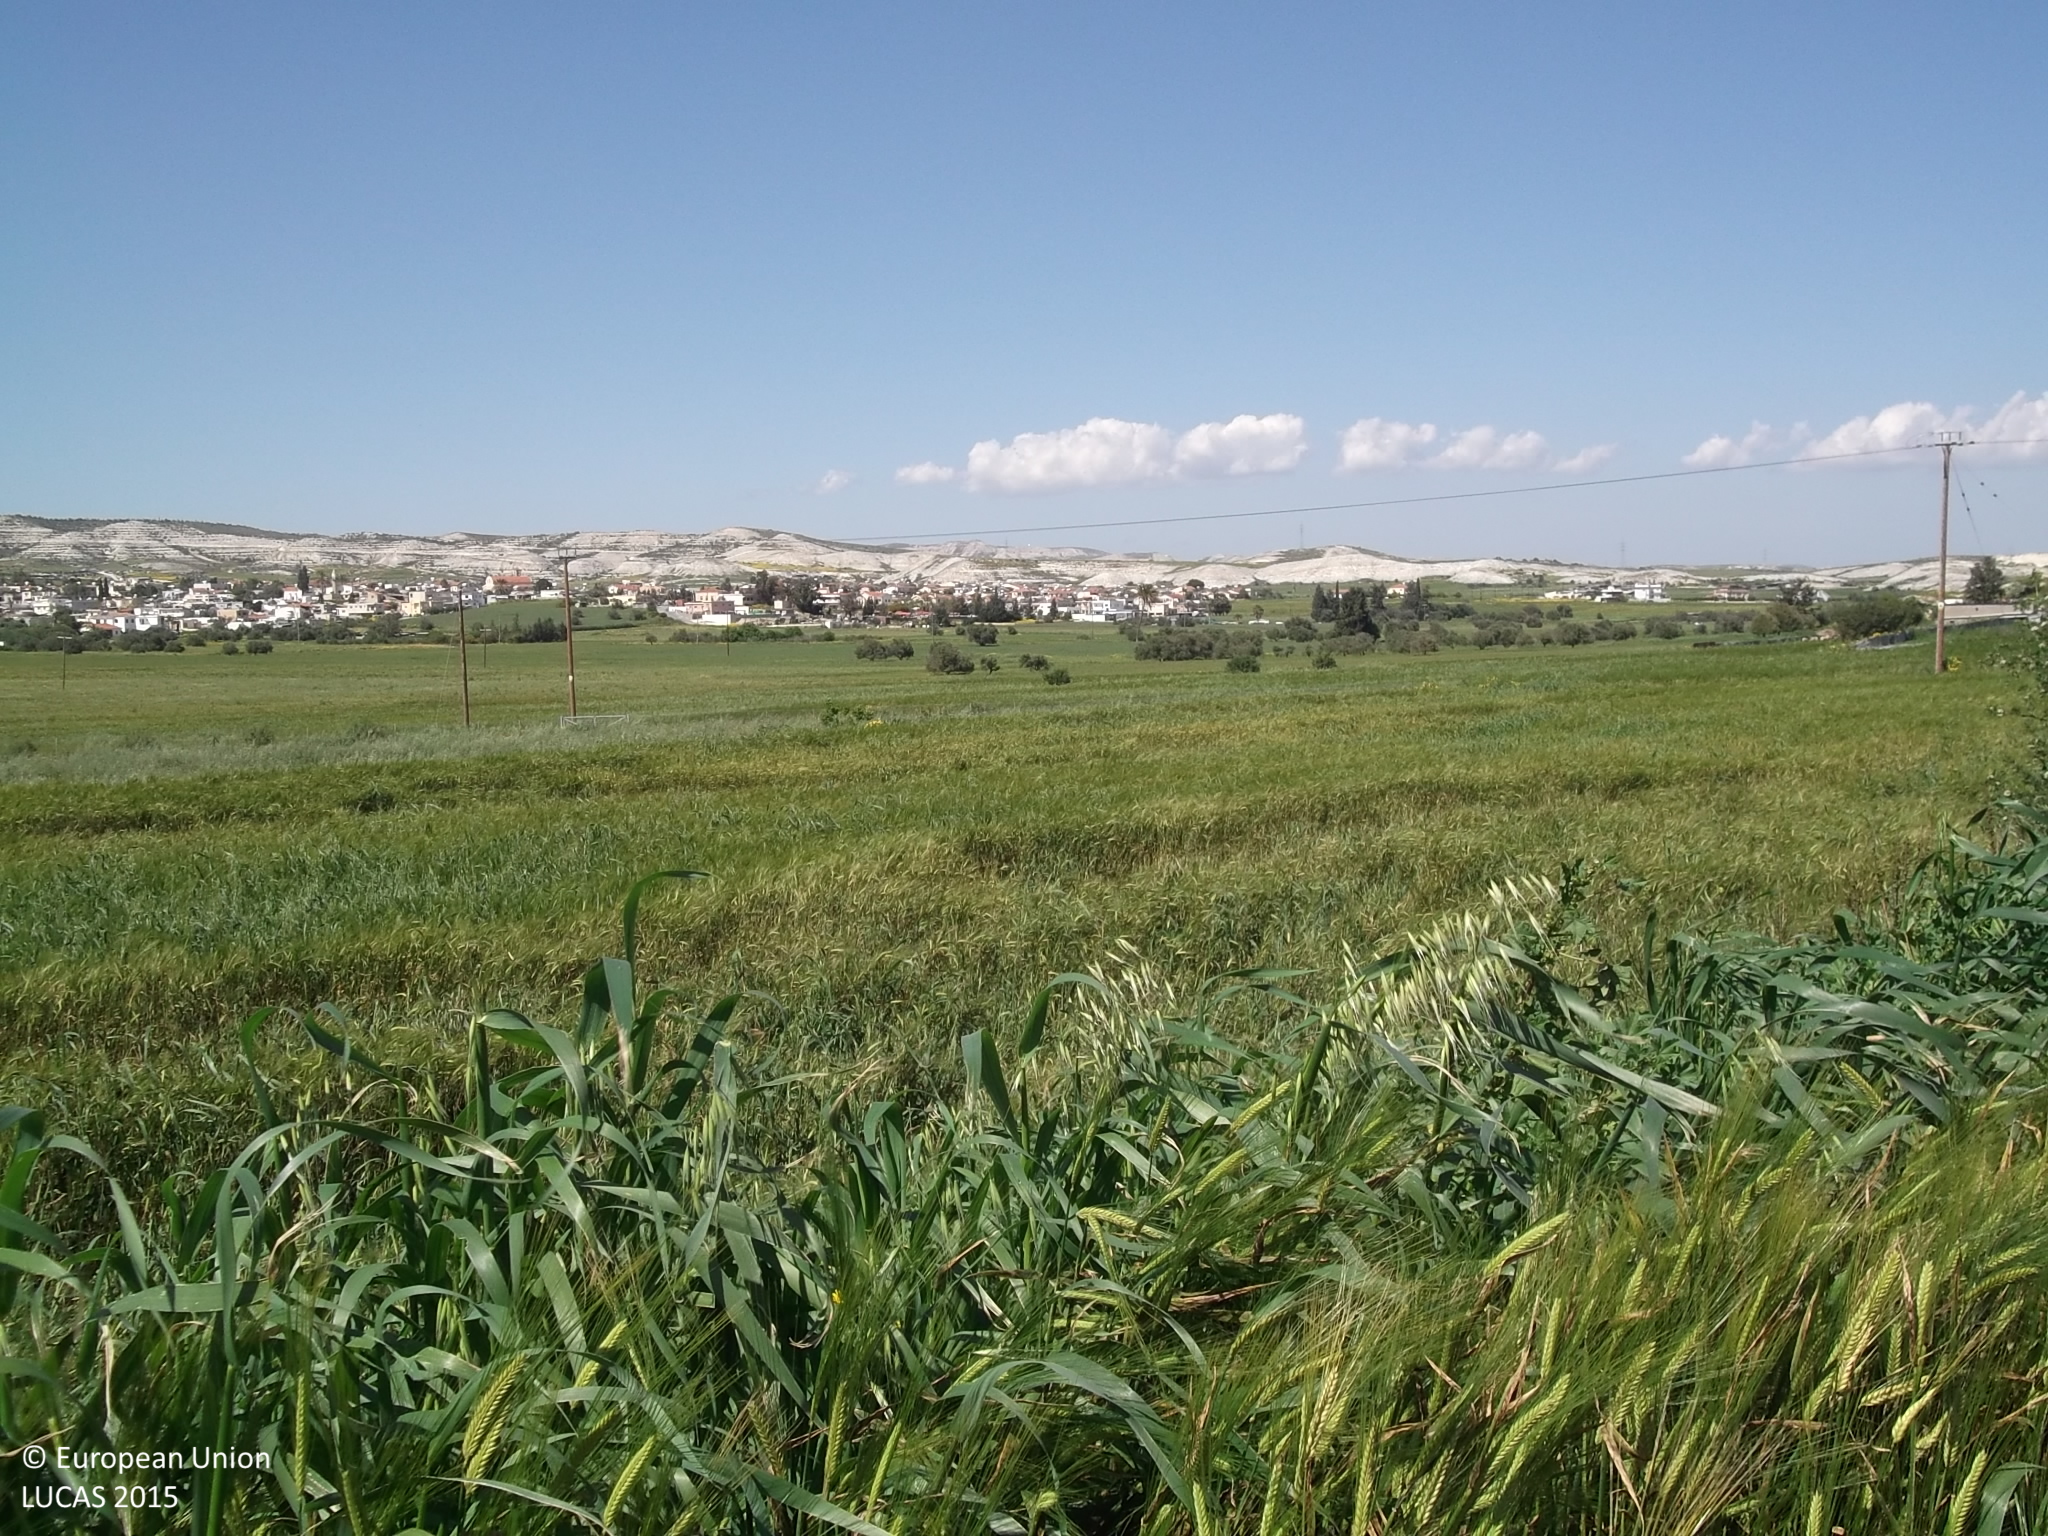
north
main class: Cropland
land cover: Mixed cereals for fodder
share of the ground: > 75 %
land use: Agriculture (excluding fallow land and kitchen gardens)
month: April
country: CY
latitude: 34.9170
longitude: 33.5399
